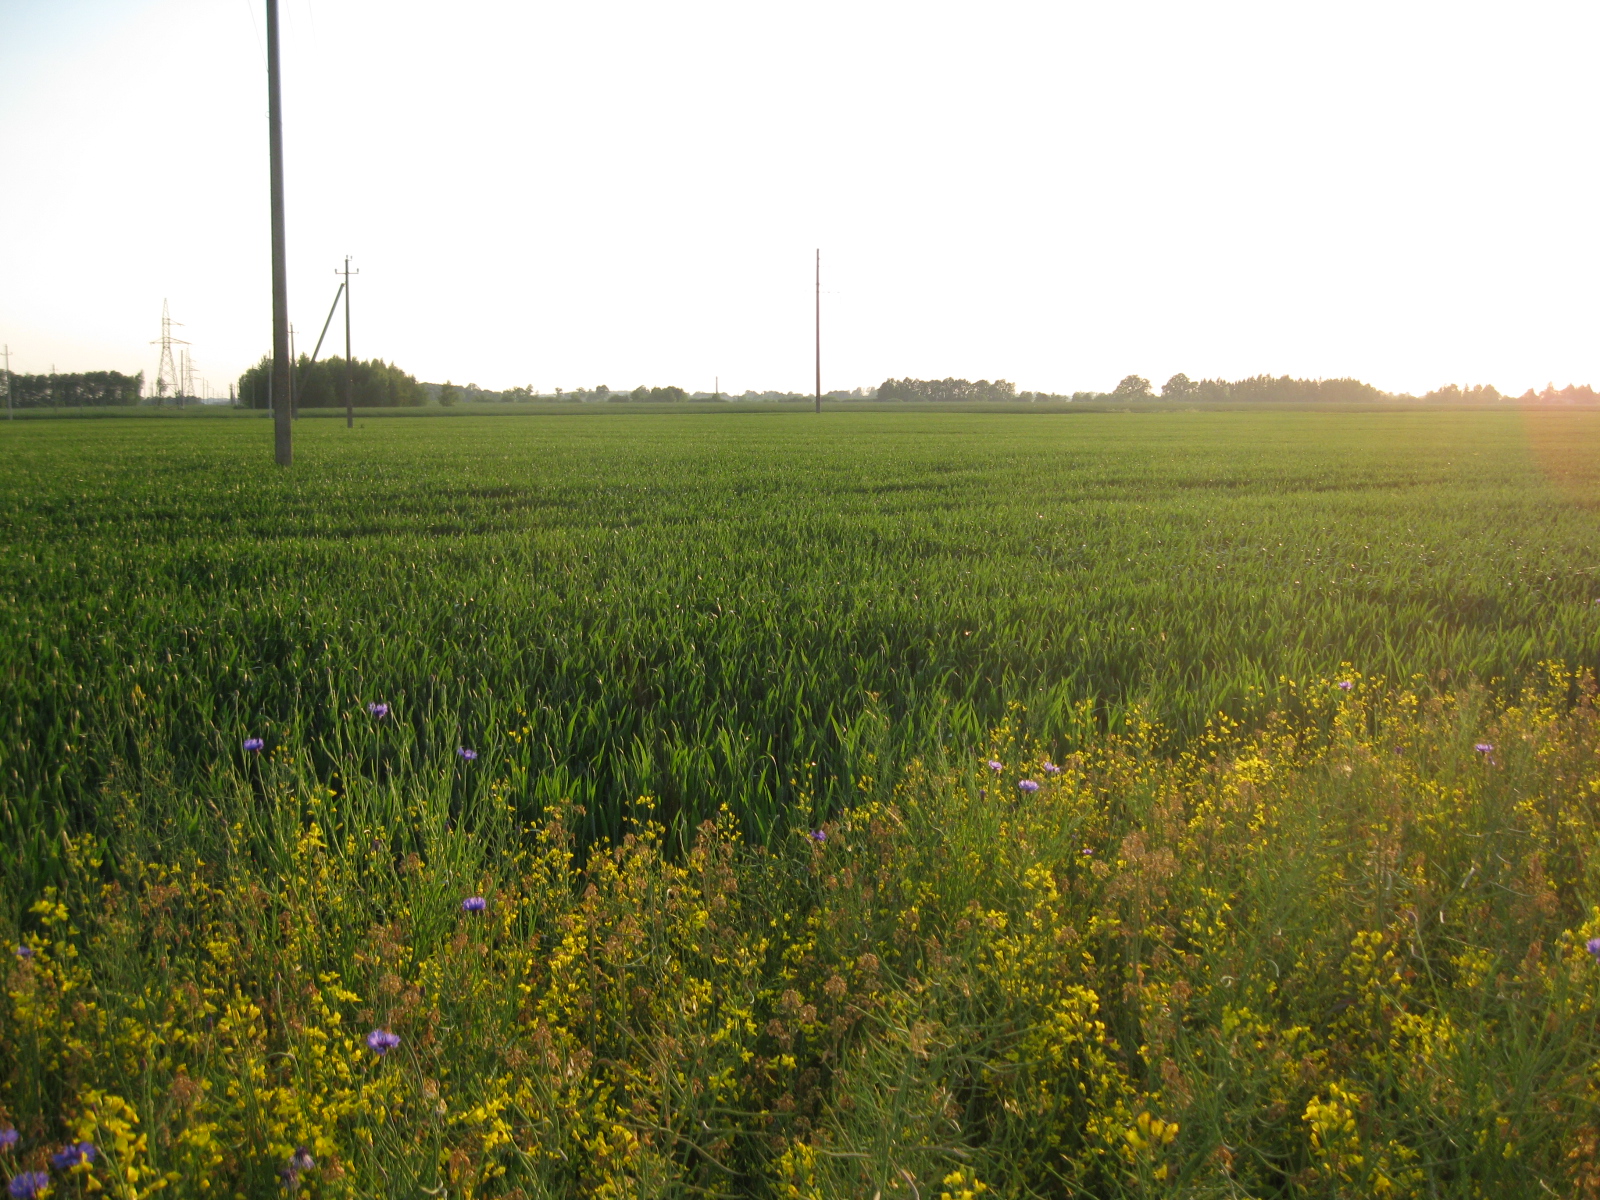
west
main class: Cropland
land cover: Rape and turnip rape
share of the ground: > 75 %
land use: Agriculture (excluding fallow land and kitchen gardens)
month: June
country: LT
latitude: 55.5088
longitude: 23.8135
